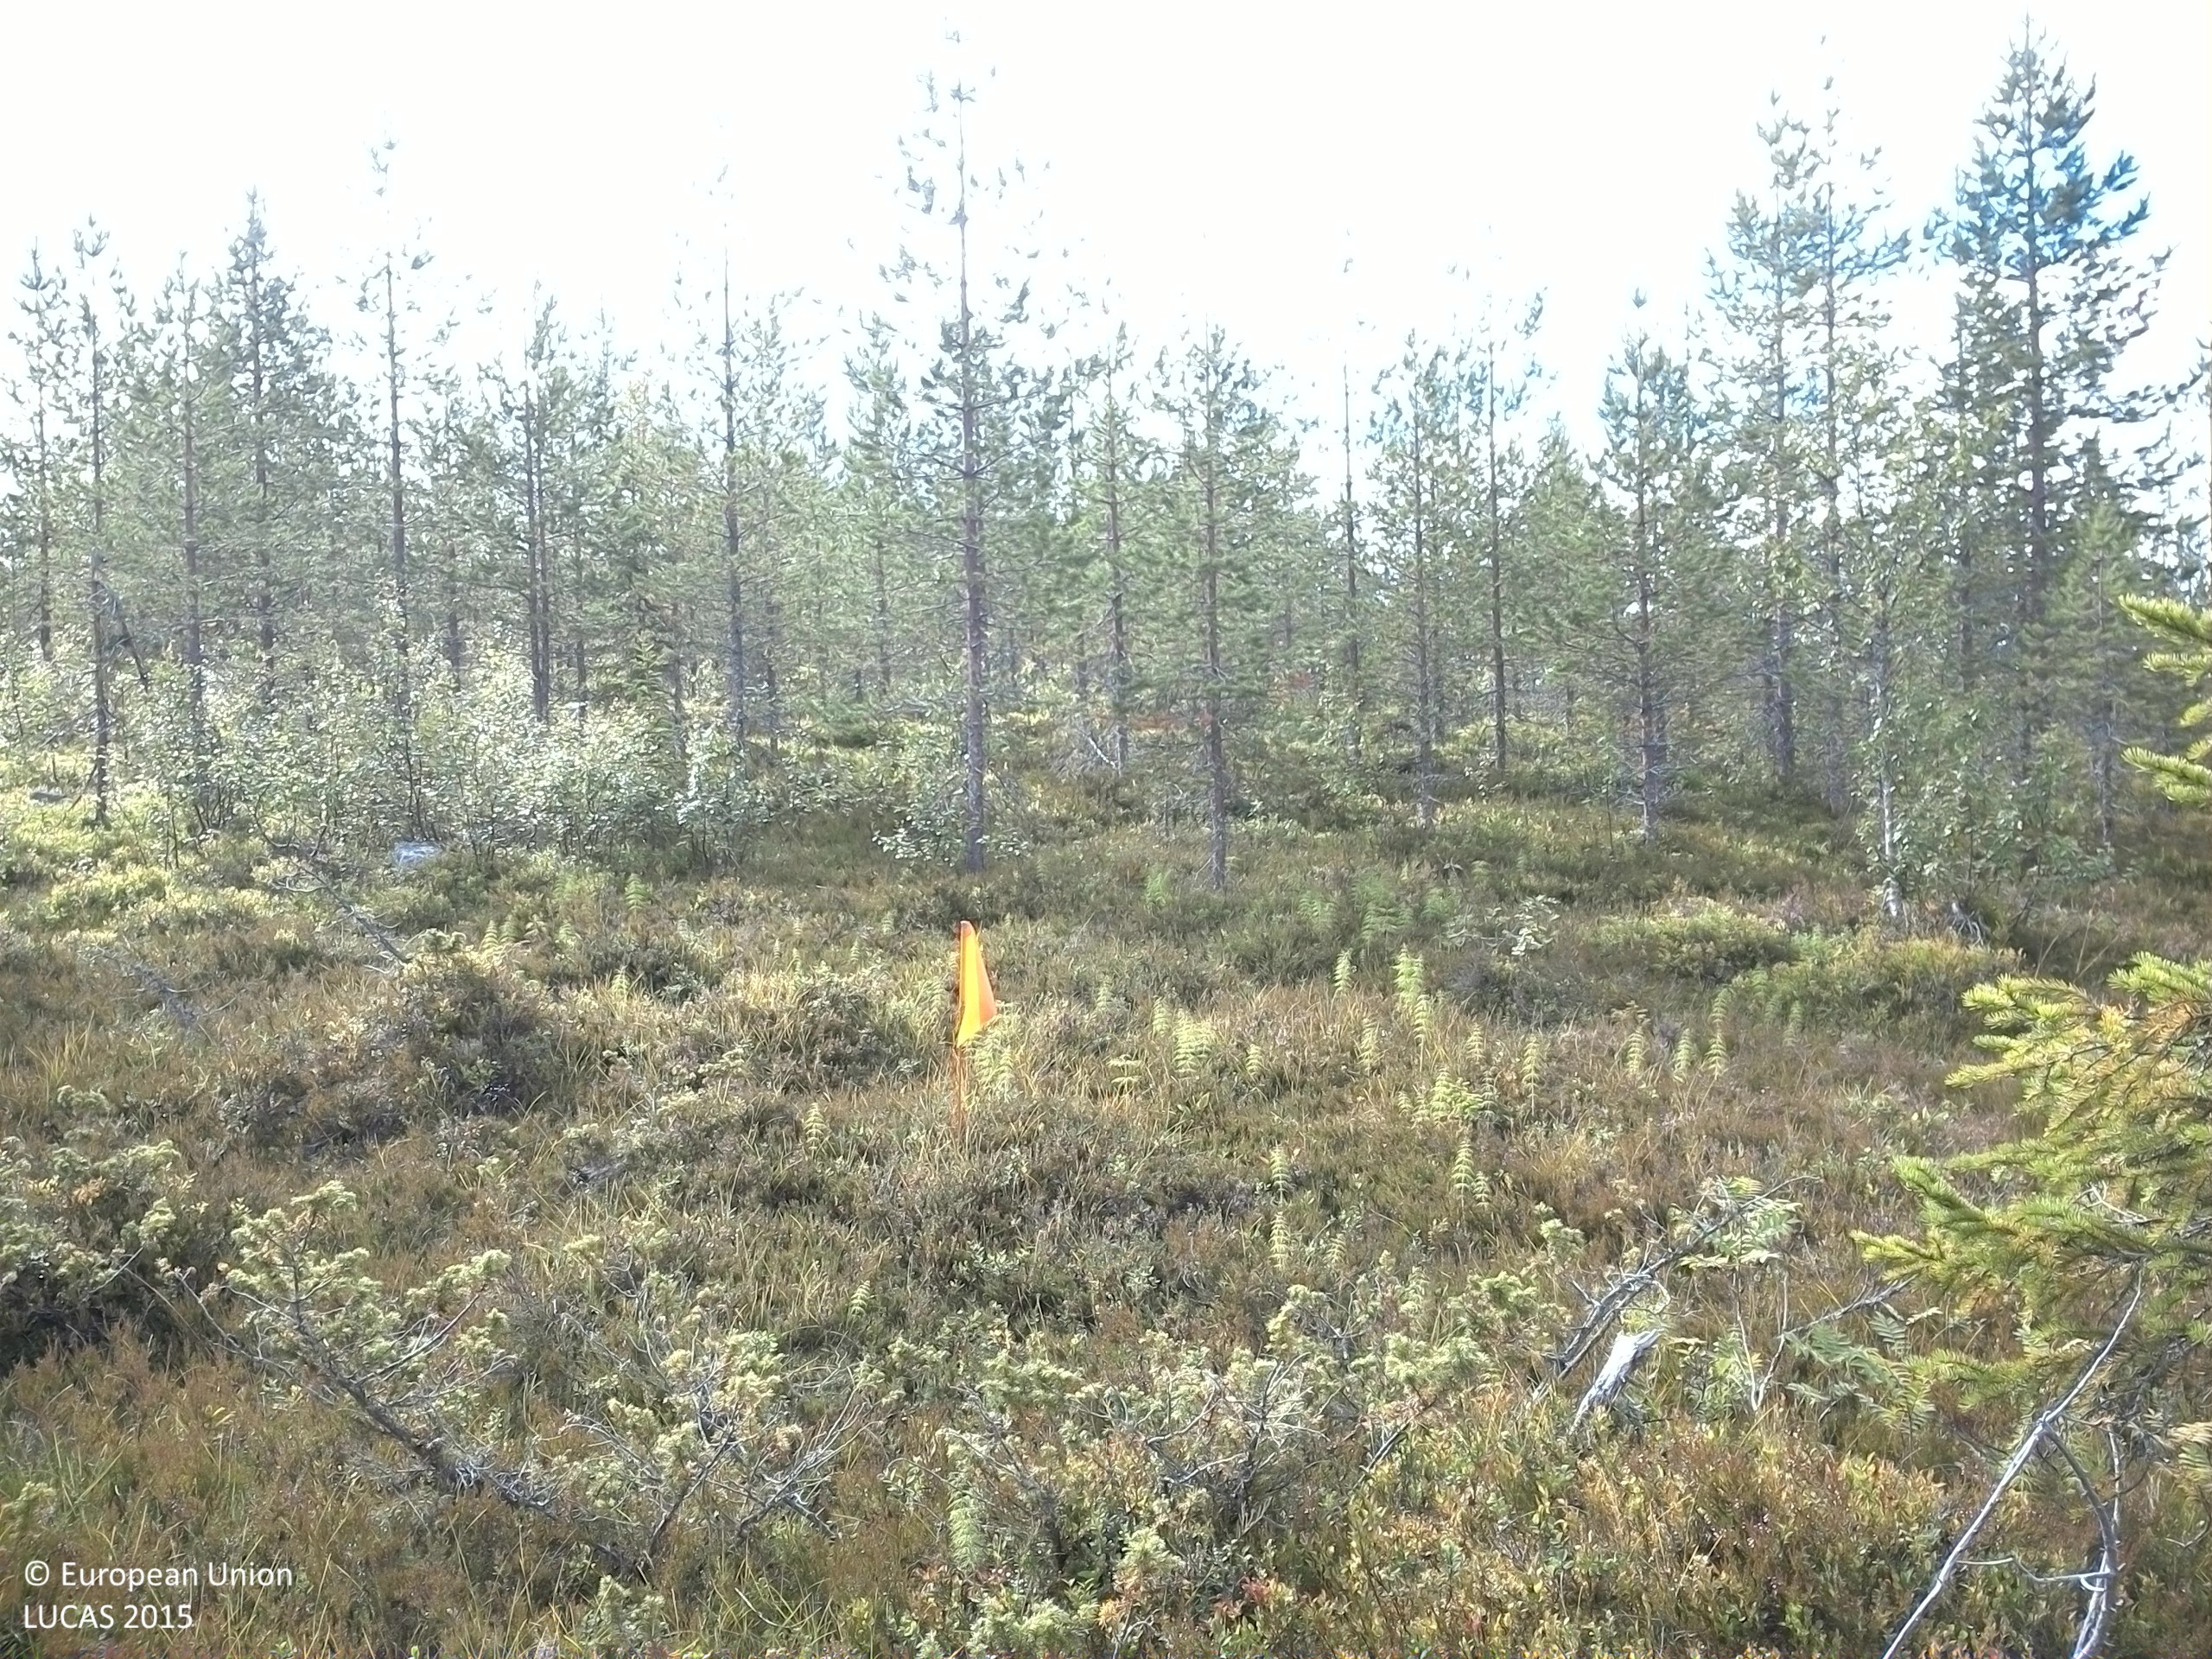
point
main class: Woodland
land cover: Pine dominated coniferous woodland
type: boreal forest
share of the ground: 25 - 50 %
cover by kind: shrubs 65 %, coniferous forest trees 25 %, broadleaved forest trees 5 %, lichens and mosses 5 %
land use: Forestry
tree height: < 5 m
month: August
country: SE
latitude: 63.7573
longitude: 18.0609
